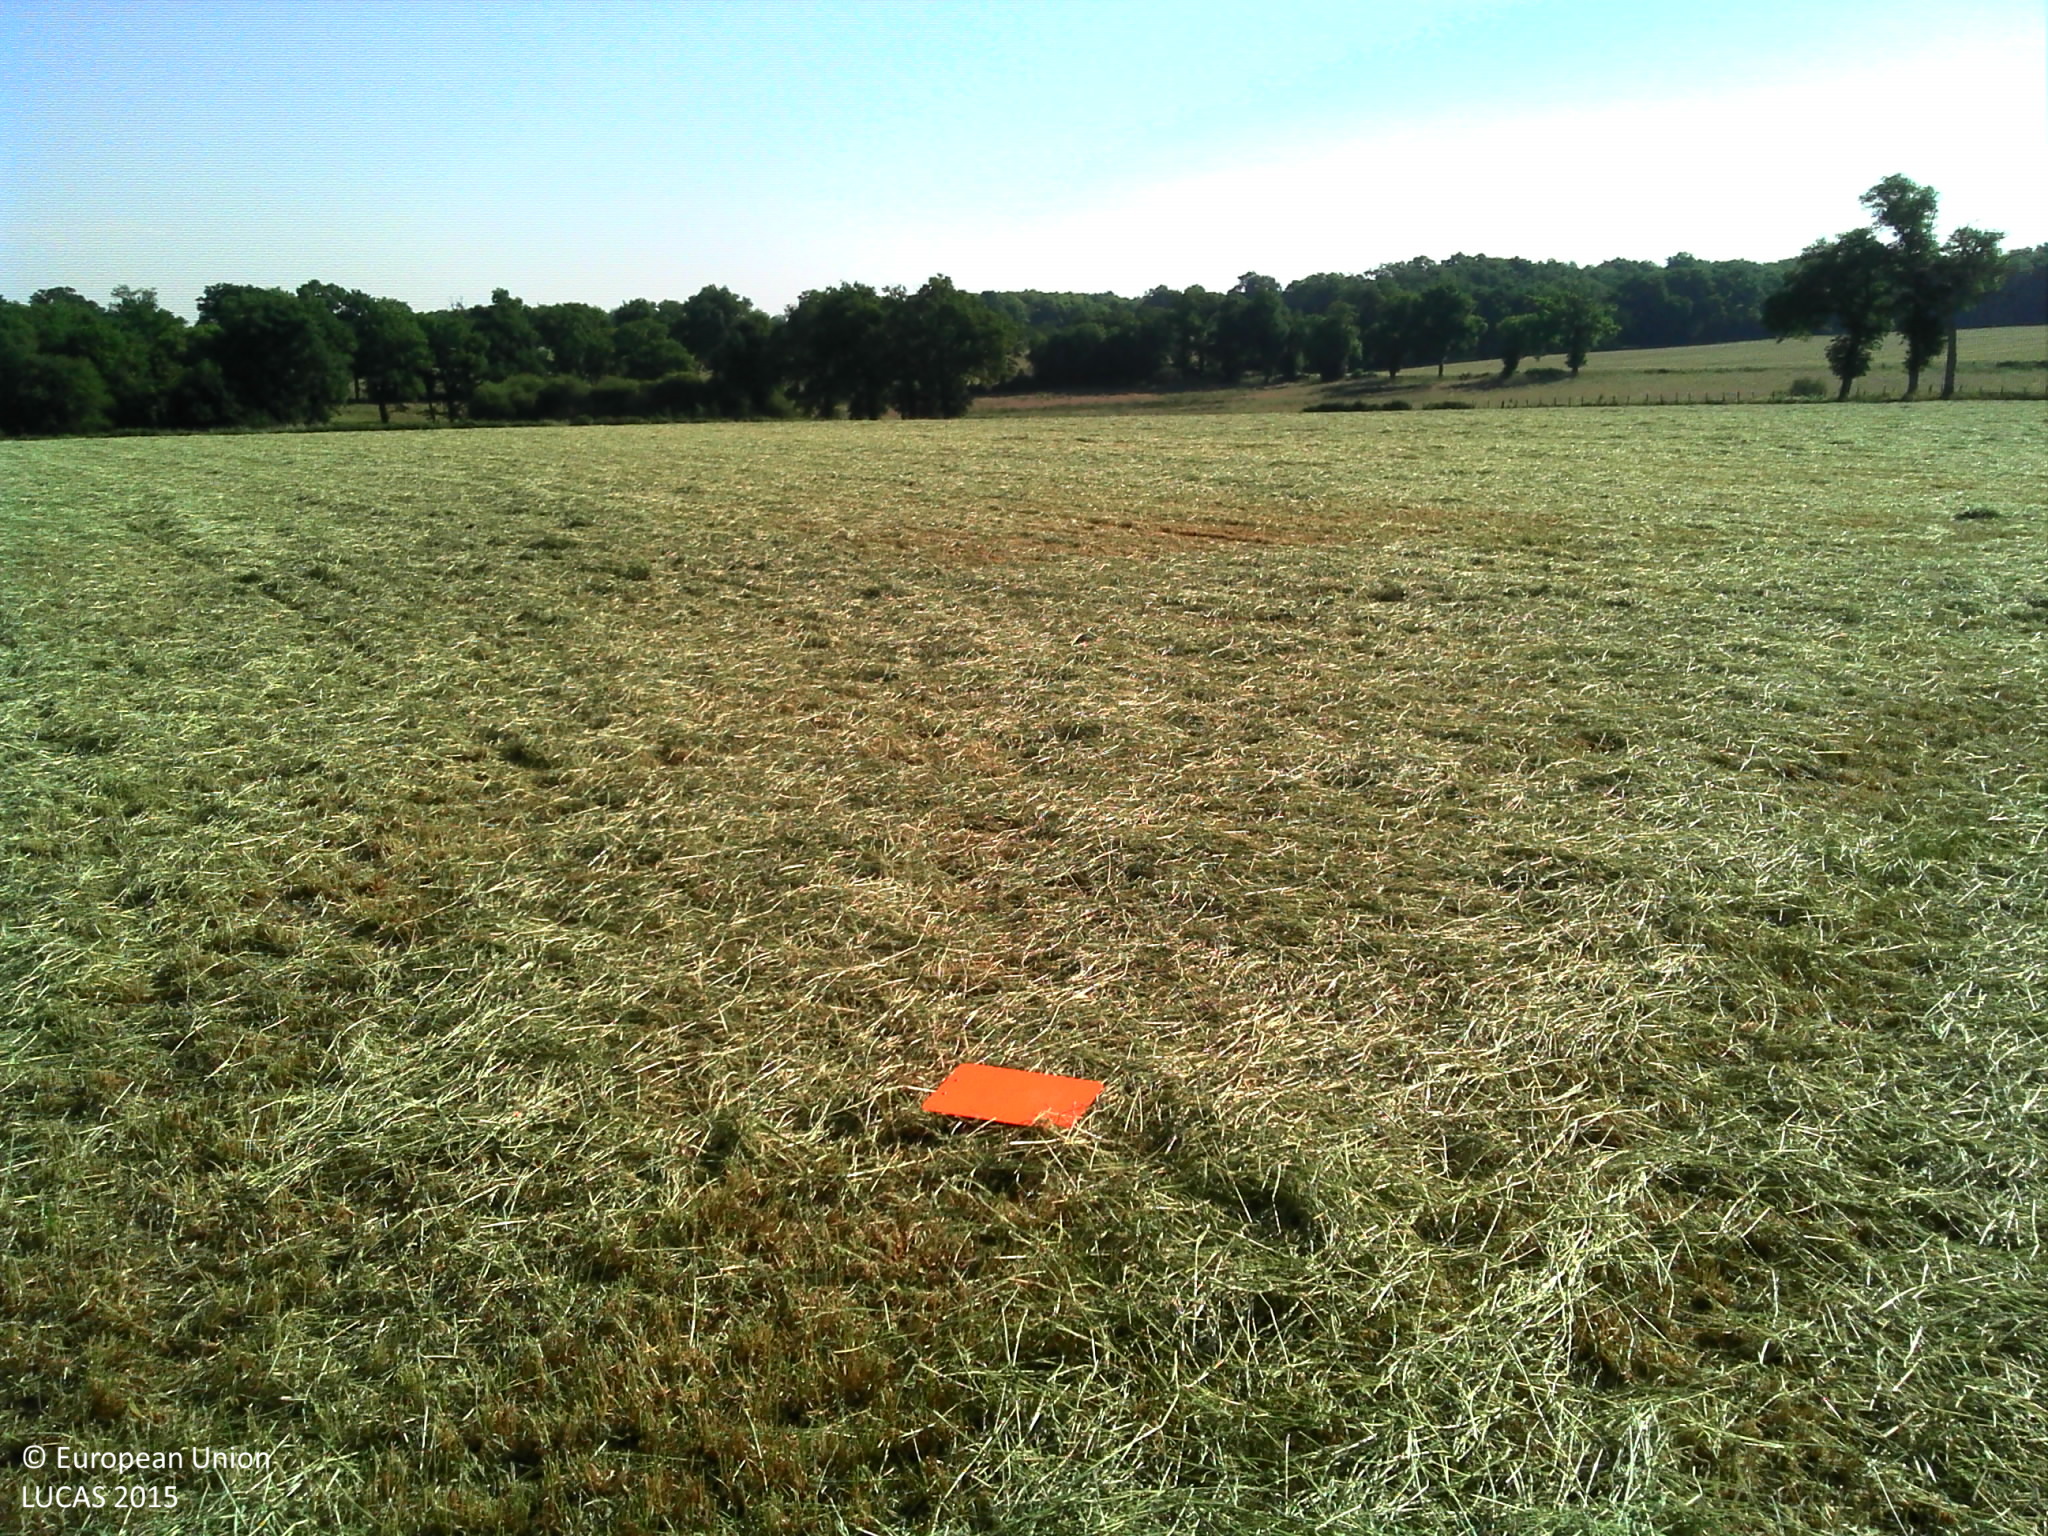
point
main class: Grassland
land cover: Grassland without tree/shrub cover
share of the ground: > 75 %
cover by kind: herbaceous plants 100 %
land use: Agriculture (excluding fallow land and kitchen gardens)
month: June
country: FR
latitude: 46.0421
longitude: 0.5647
